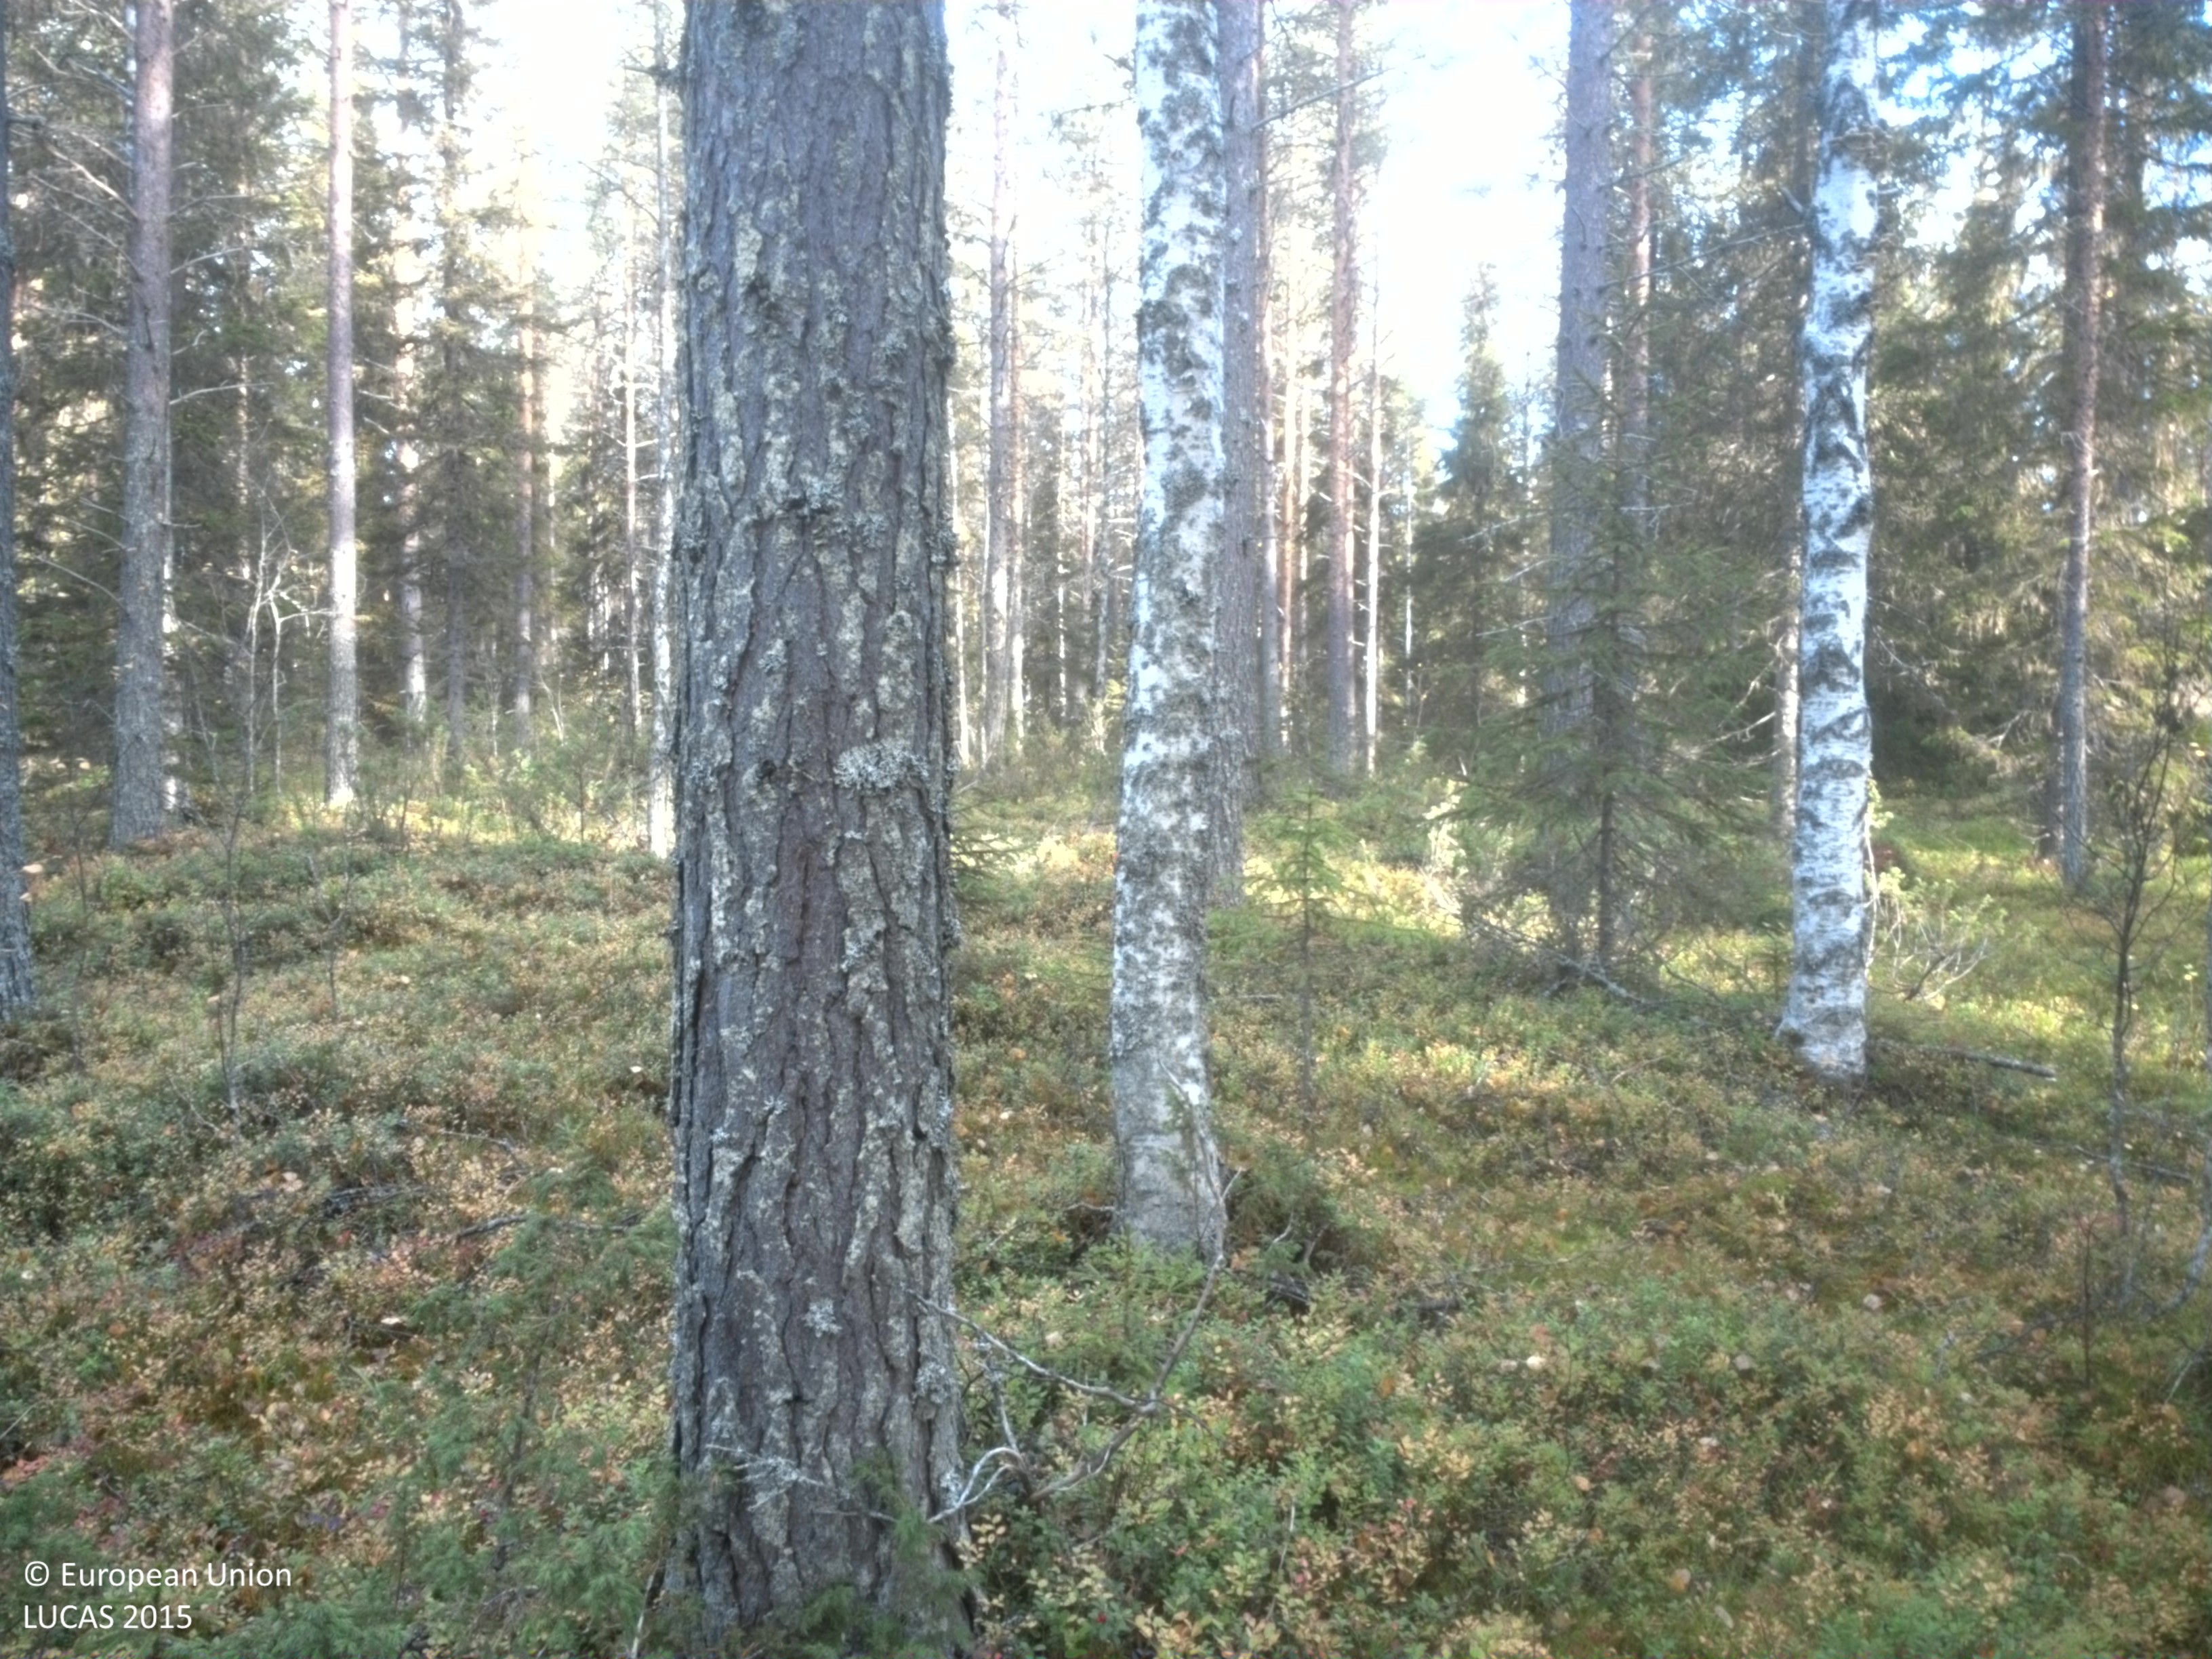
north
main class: Woodland
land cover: Spruce dominated coniferous woodland
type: boreal forest
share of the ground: 50 - 75 %
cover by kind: coniferous forest trees 55 %, shrubs 35 %, broadleaved forest trees 5 %, lichens and mosses 5 %
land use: Forestry
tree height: > 5 m
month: September
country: SE
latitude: 64.2523
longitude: 19.8998
